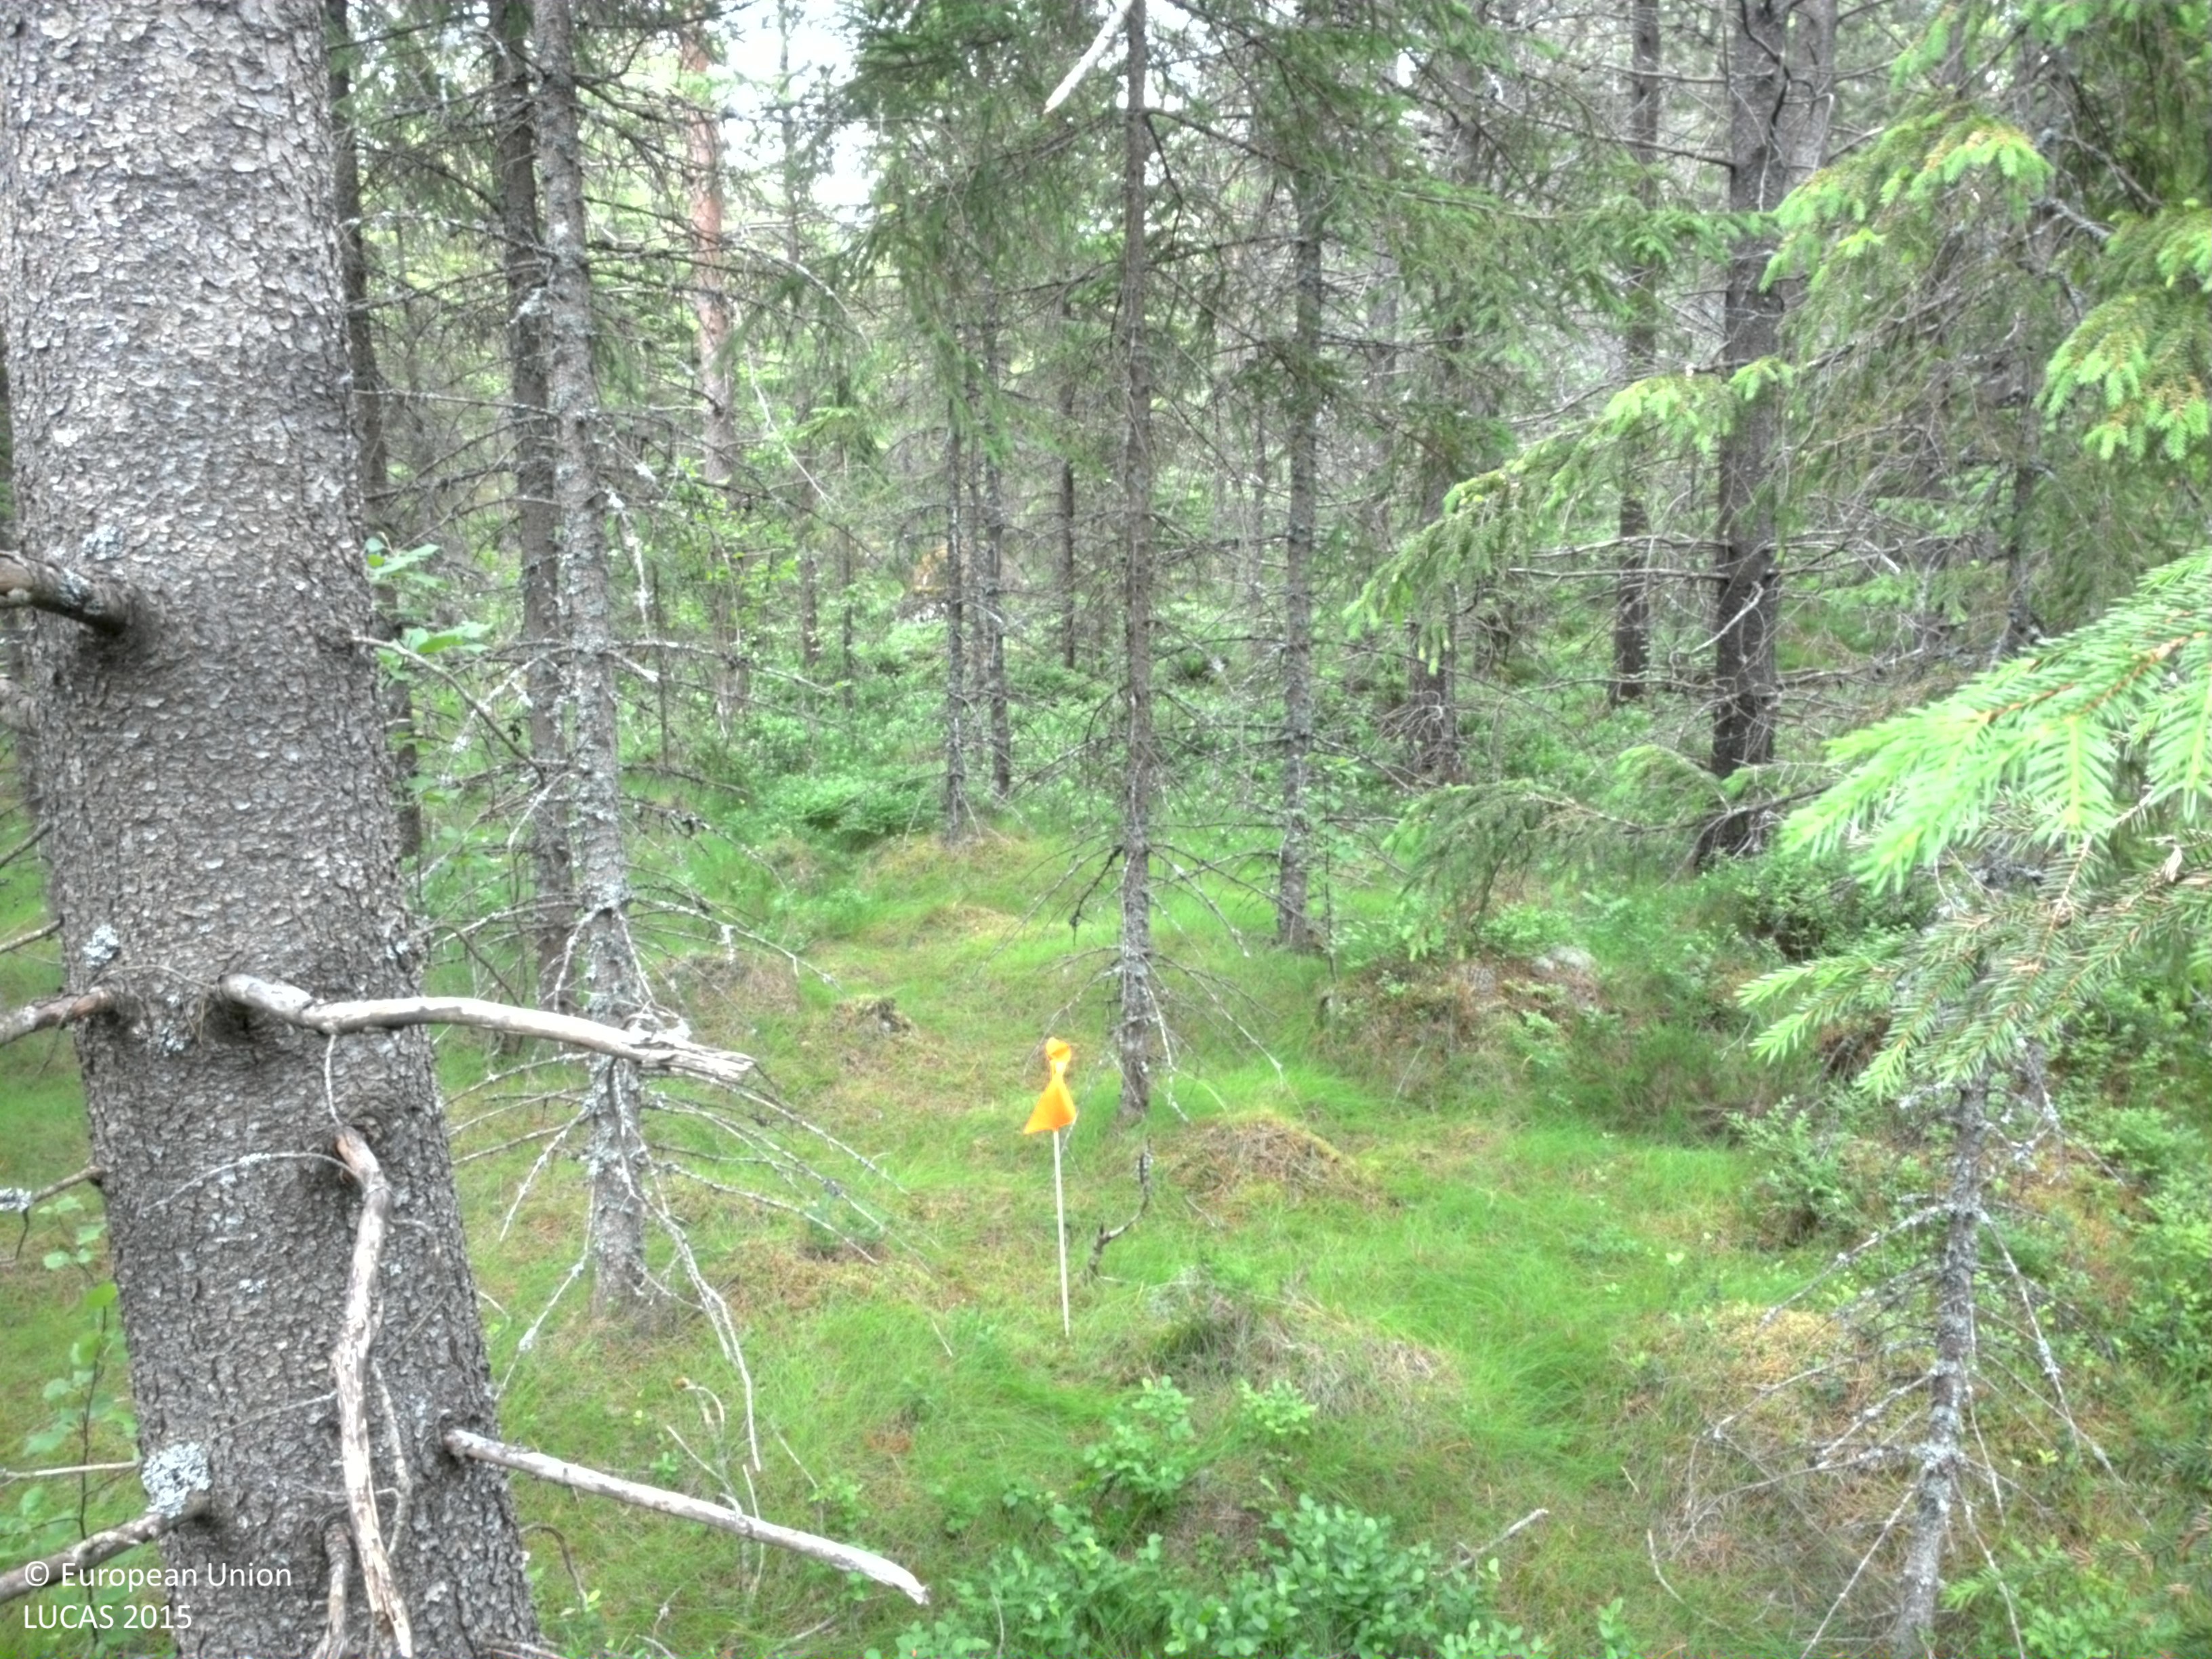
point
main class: Woodland
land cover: Spruce dominated mixed woodland
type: boreal forest
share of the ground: 50 - 75 %
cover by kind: coniferous forest trees 50 %, broadleaved forest trees 20 %, shrubs 10 %, herbaceous plants 10 %, lichens and mosses 5 %, consolidated bare surface 5 %
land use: Forestry
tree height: > 5 m
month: July
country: SE
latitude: 59.5285
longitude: 14.6051
